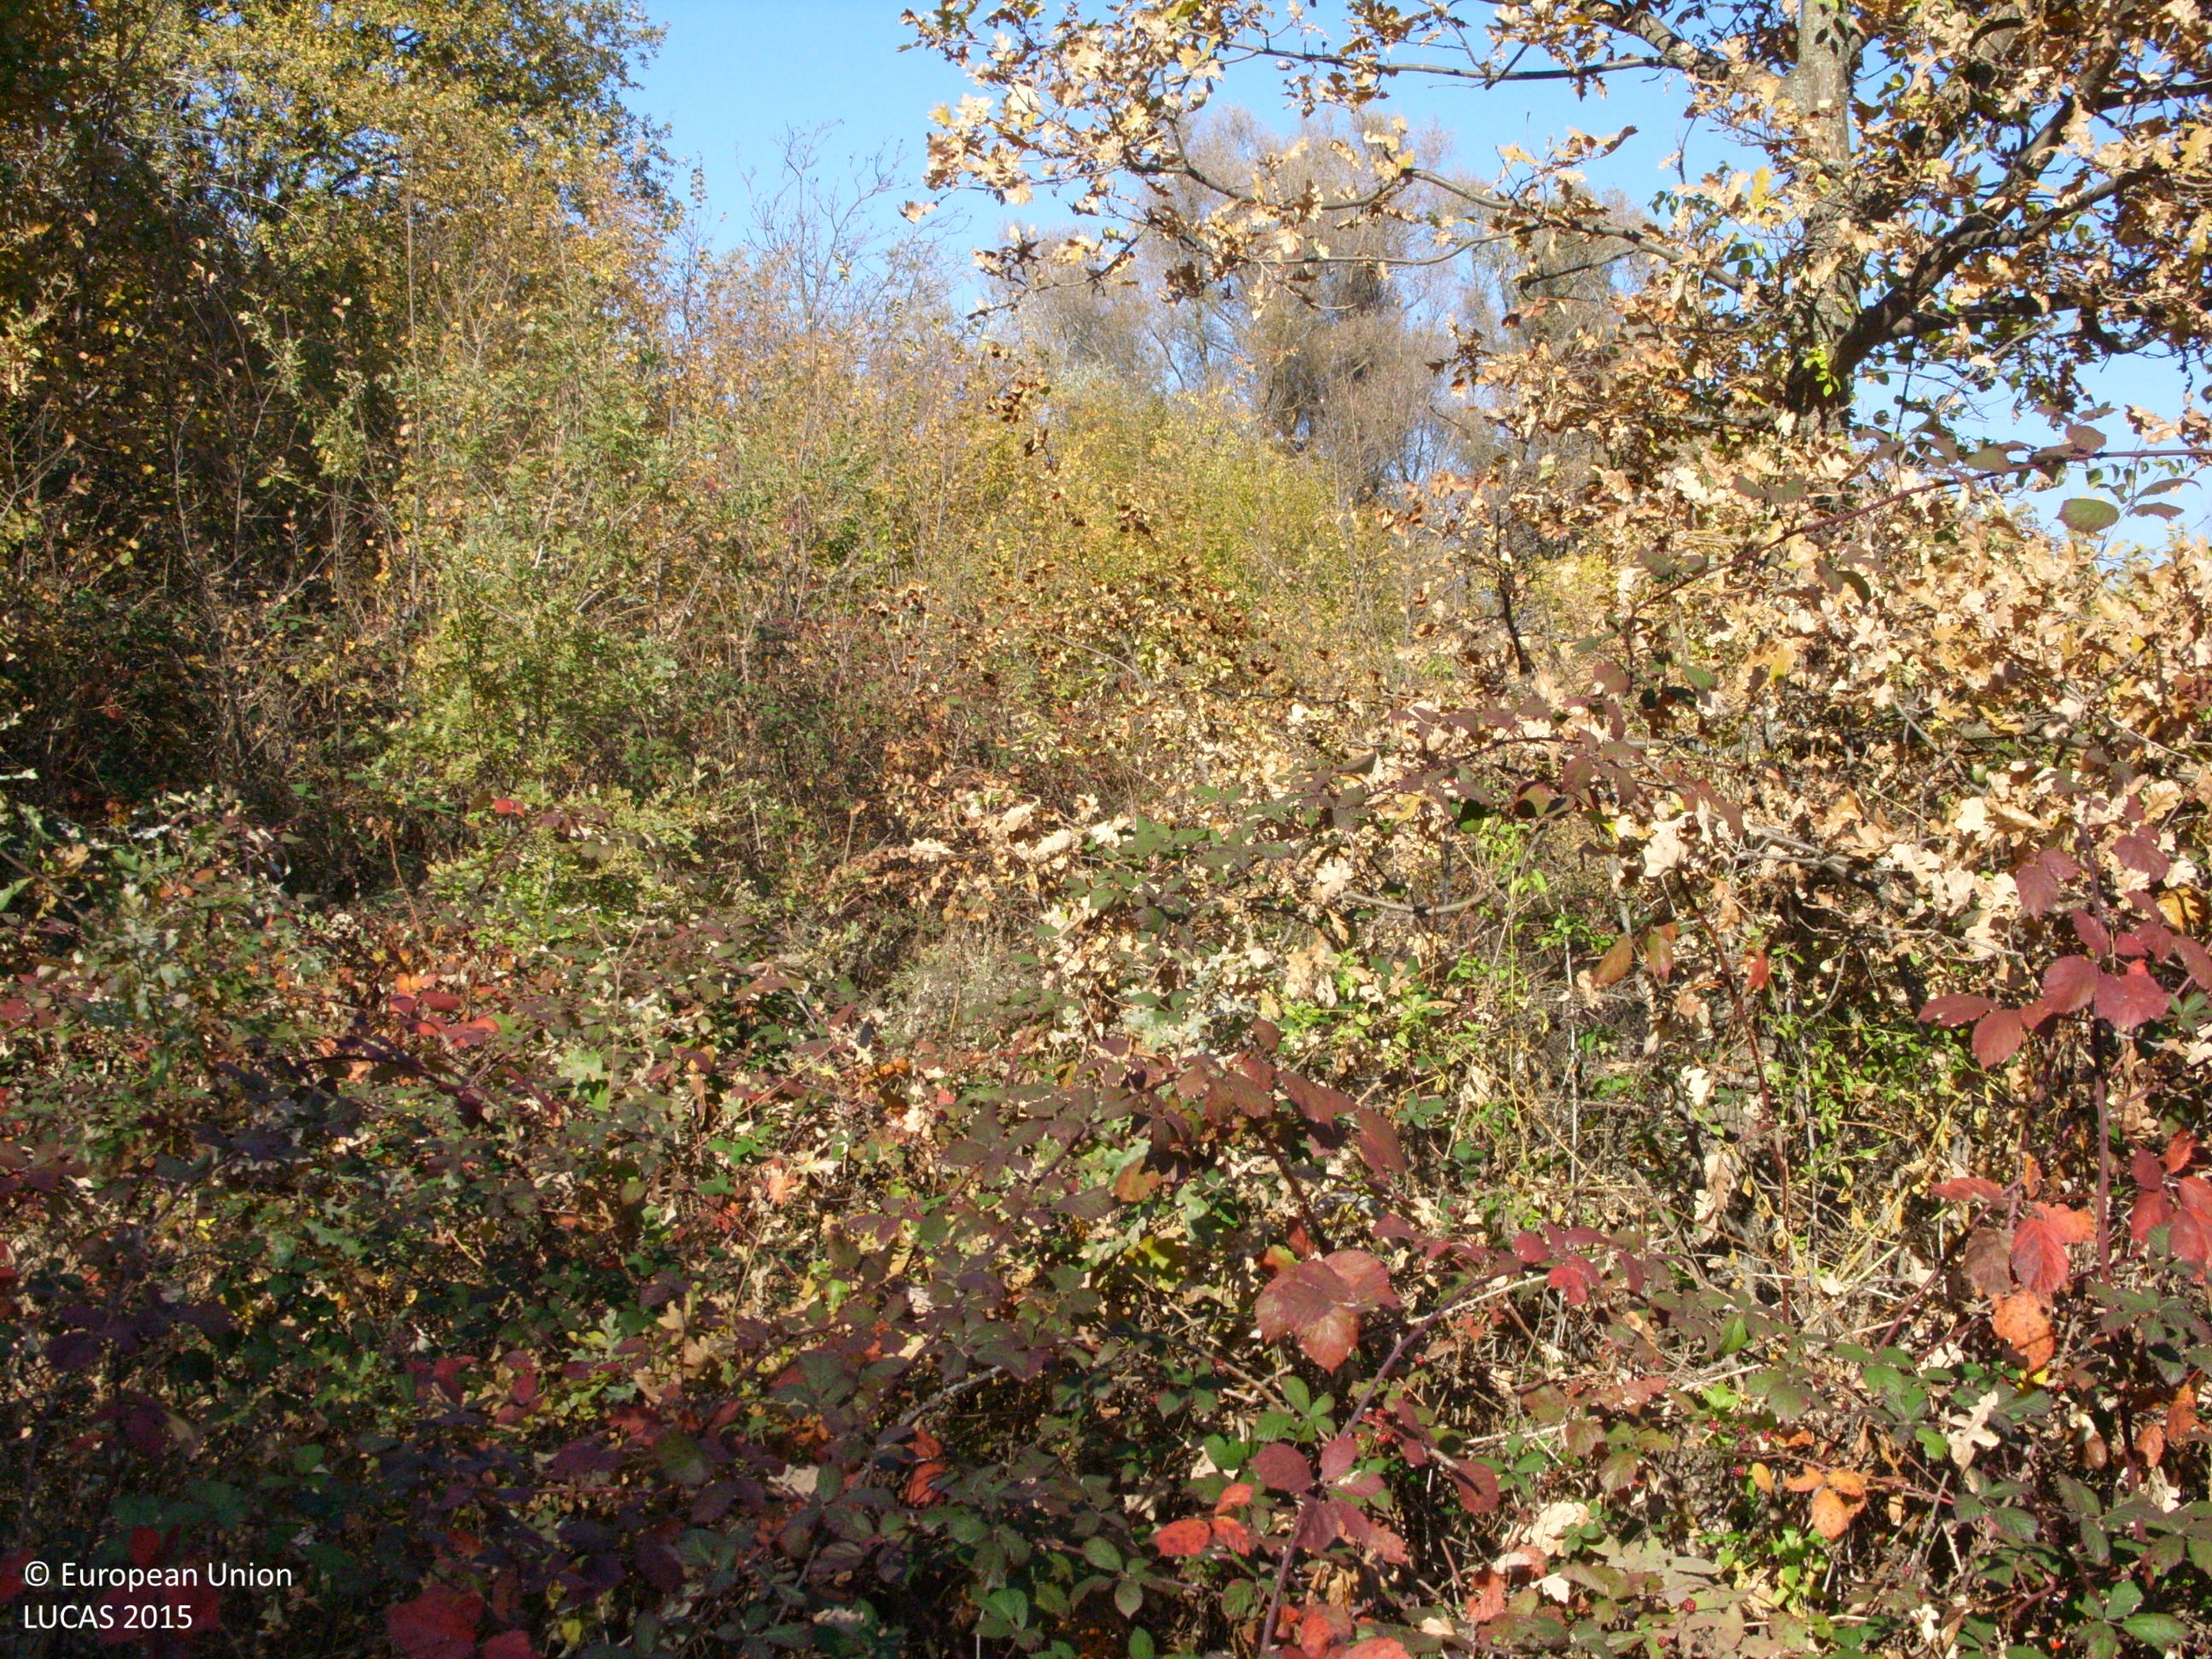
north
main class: Woodland
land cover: Broadleaved woodland
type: mesophytic deciduous forest
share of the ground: > 75 %
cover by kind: broadleaved forest trees 90 %, shrubs 10 %
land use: Semi-natural and natural areas not in use
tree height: > 5 m
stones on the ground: < 10 %
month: November
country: BG
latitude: 42.4464
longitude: 24.8781
